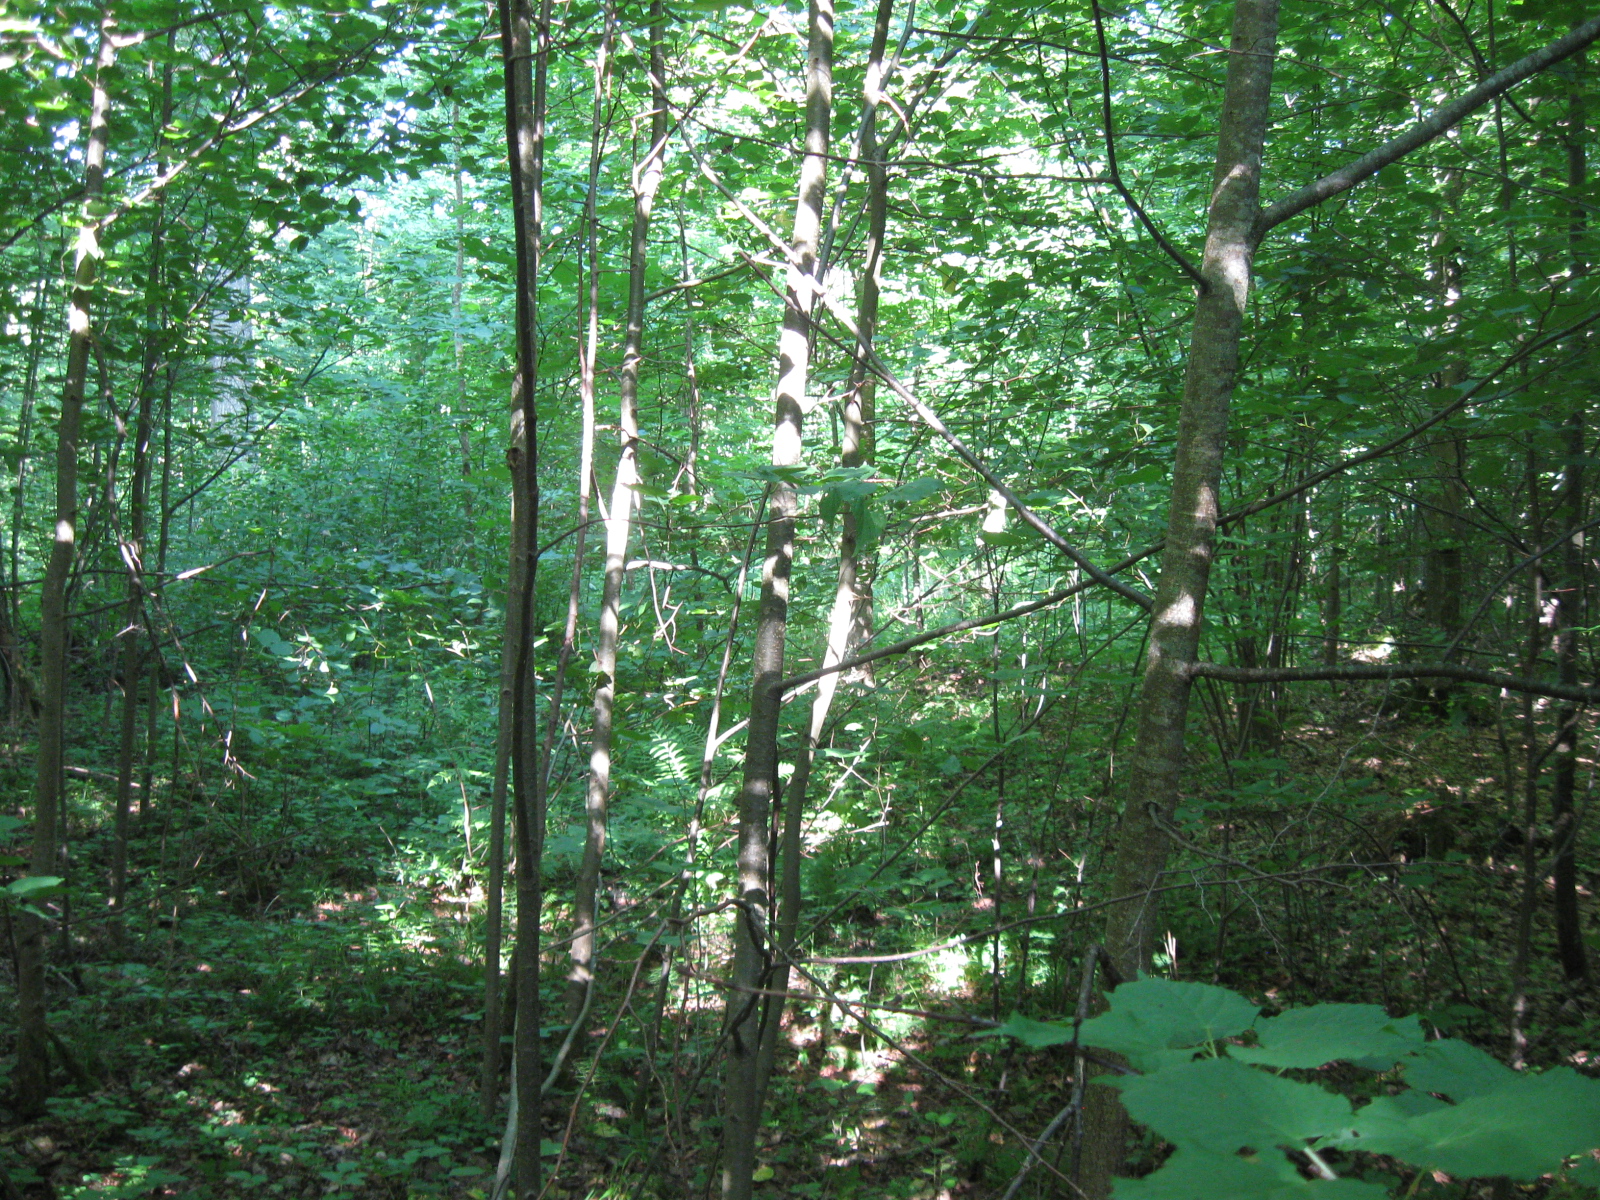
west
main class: Woodland
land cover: Broadleaved woodland
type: non-riverine alder, birch or aspen forest
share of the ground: > 75 %
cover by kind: broadleaved forest trees 90 %, herbaceous plants 10 %
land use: Forestry
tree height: > 5 m
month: July
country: LT
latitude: 54.7744
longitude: 23.8462
